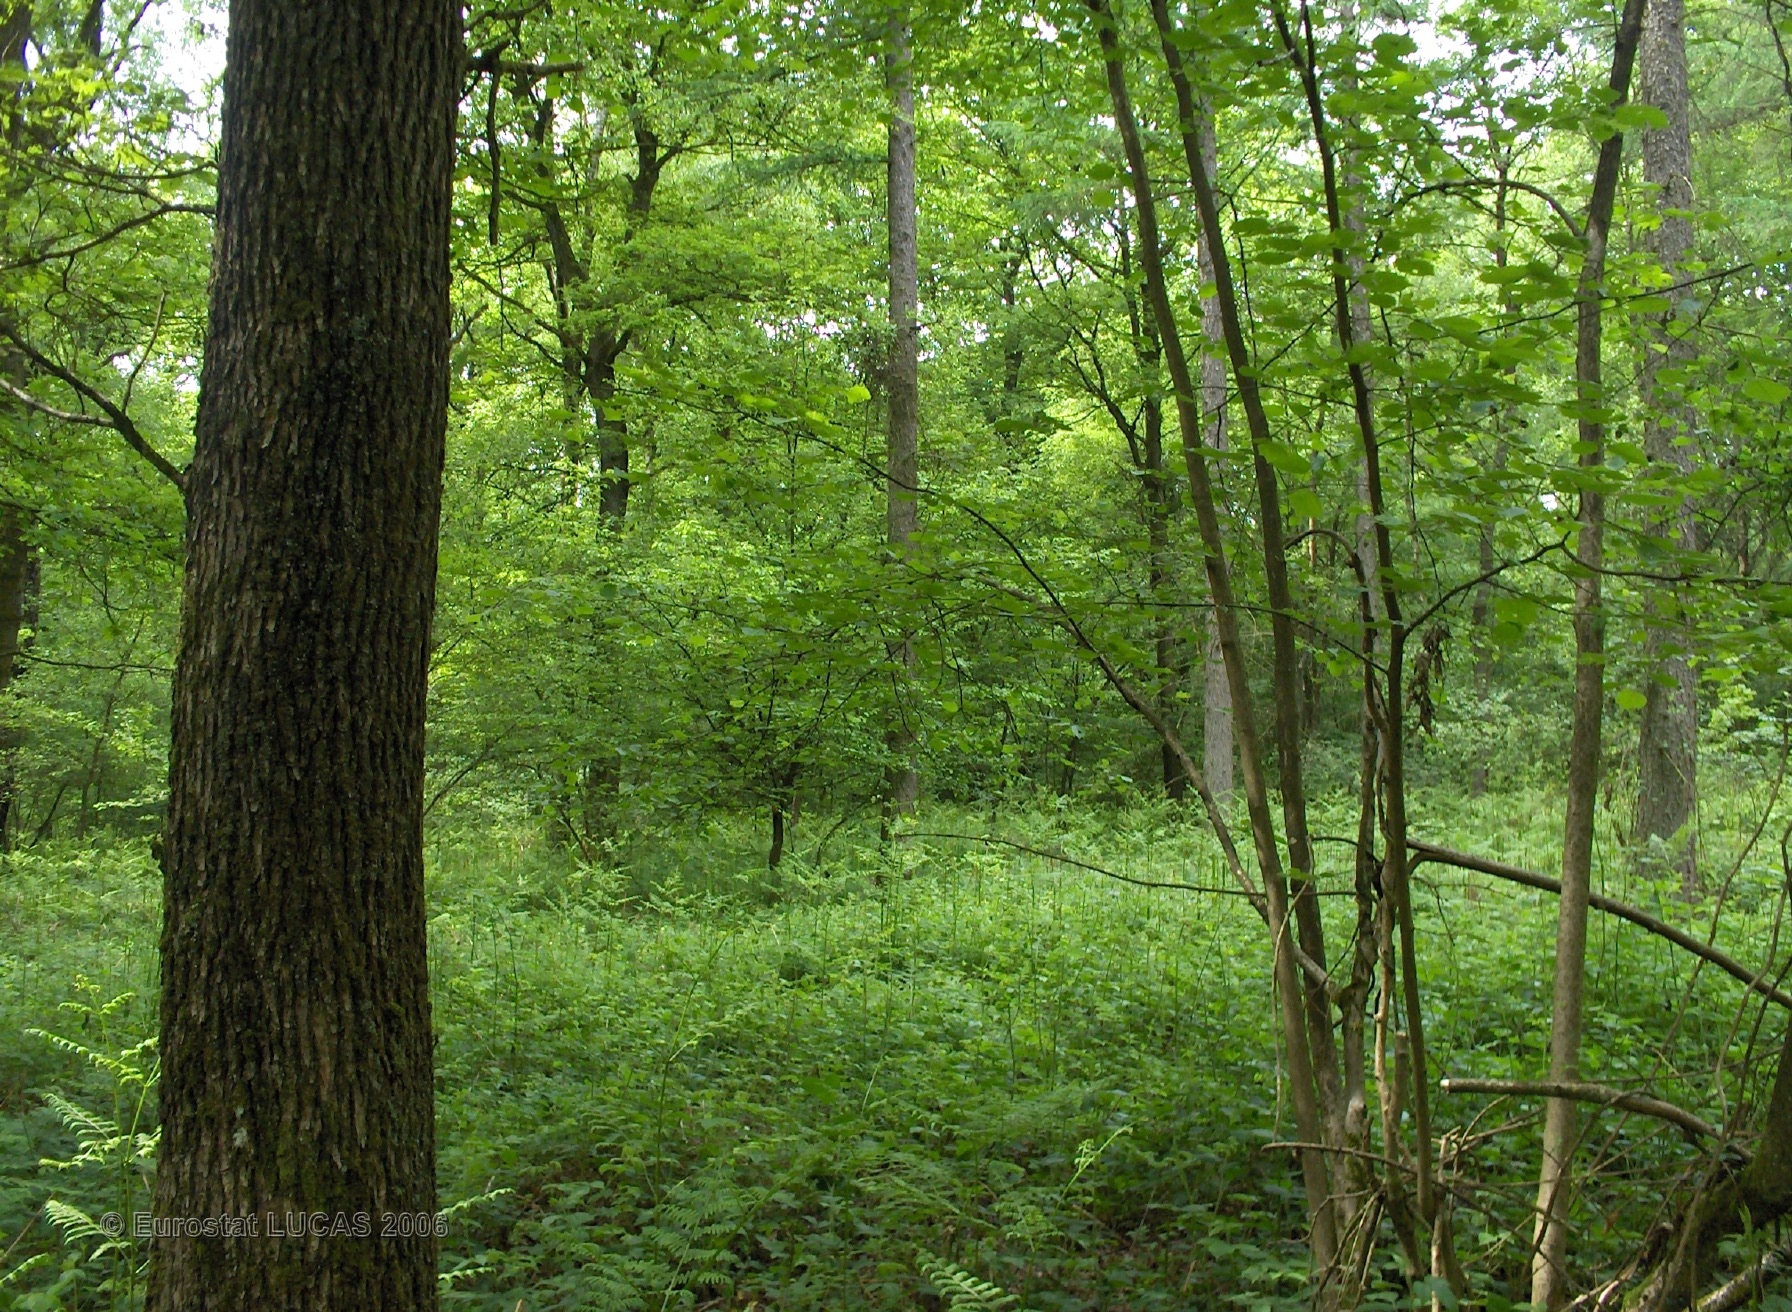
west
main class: Woodland
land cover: Broadleaved forest
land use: Forestry
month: June
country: BE
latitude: 50.2172
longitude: 4.5725
